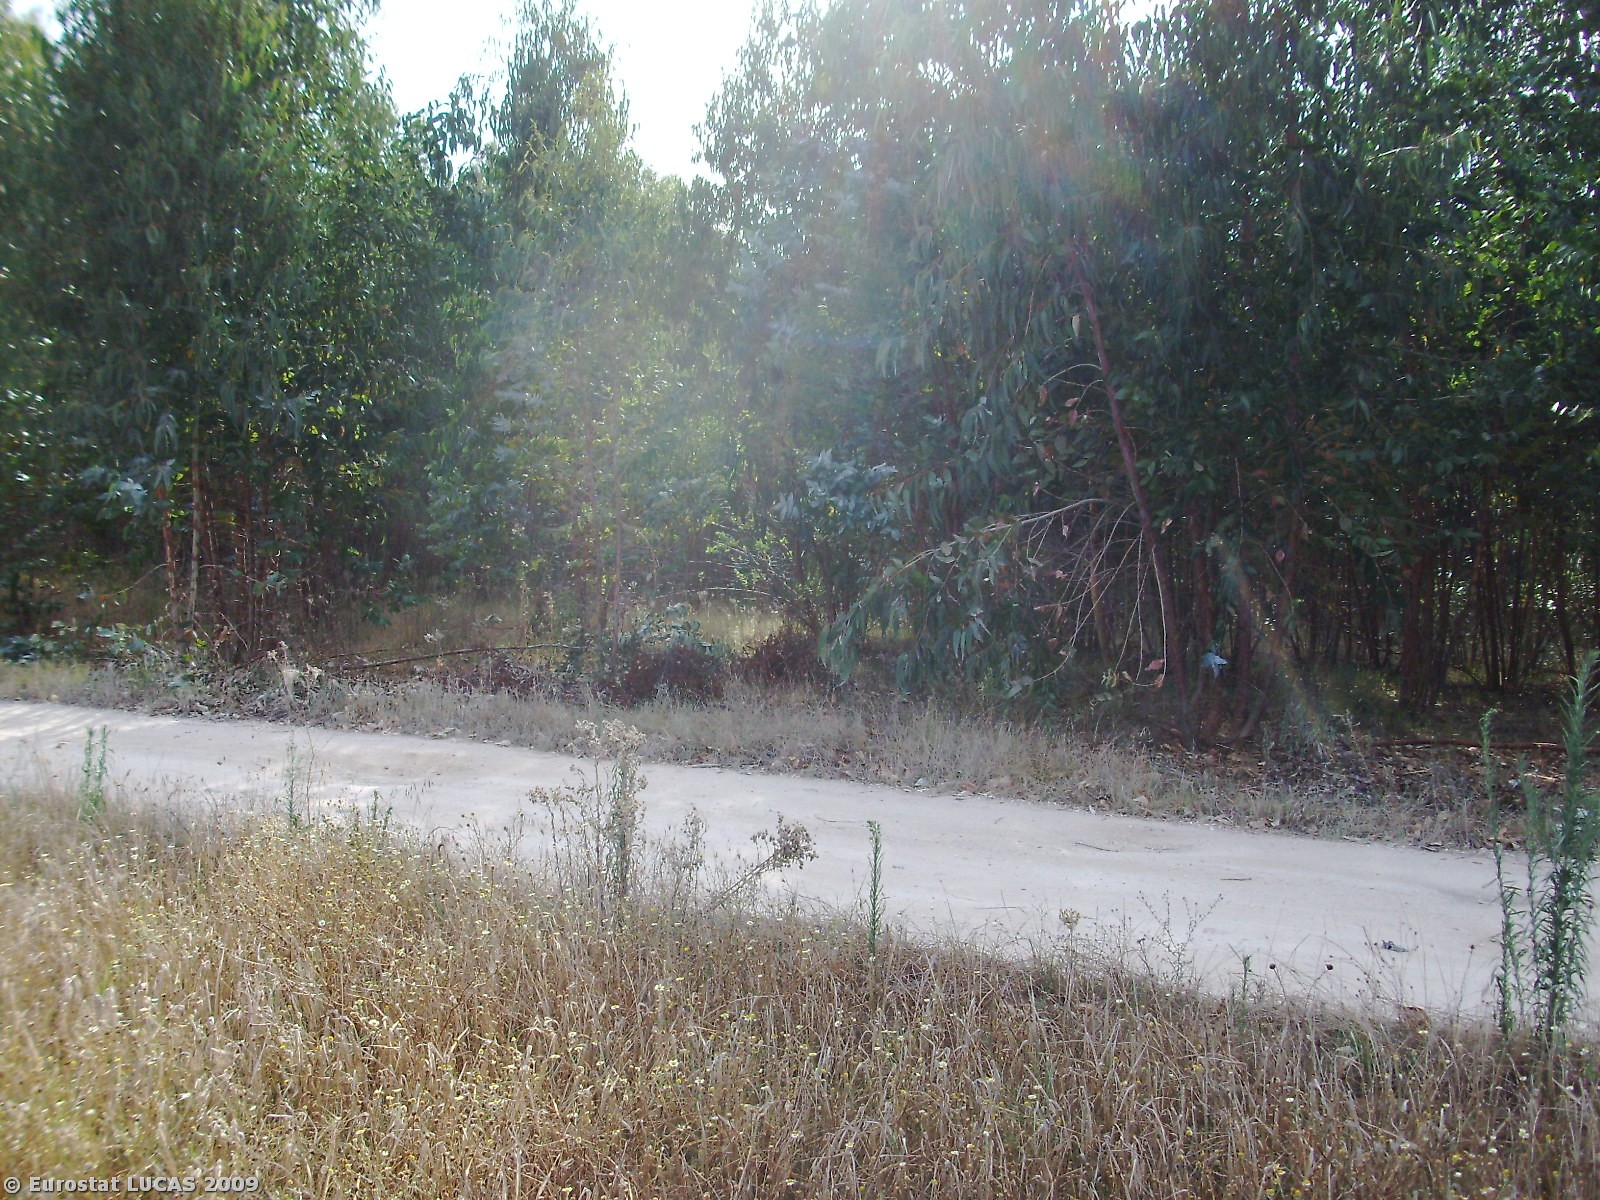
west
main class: Cropland
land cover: Barley
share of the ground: > 75 %
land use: Agriculture (excluding fallow land and kitchen gardens)
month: July
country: PT
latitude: 39.3621
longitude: -8.7749
